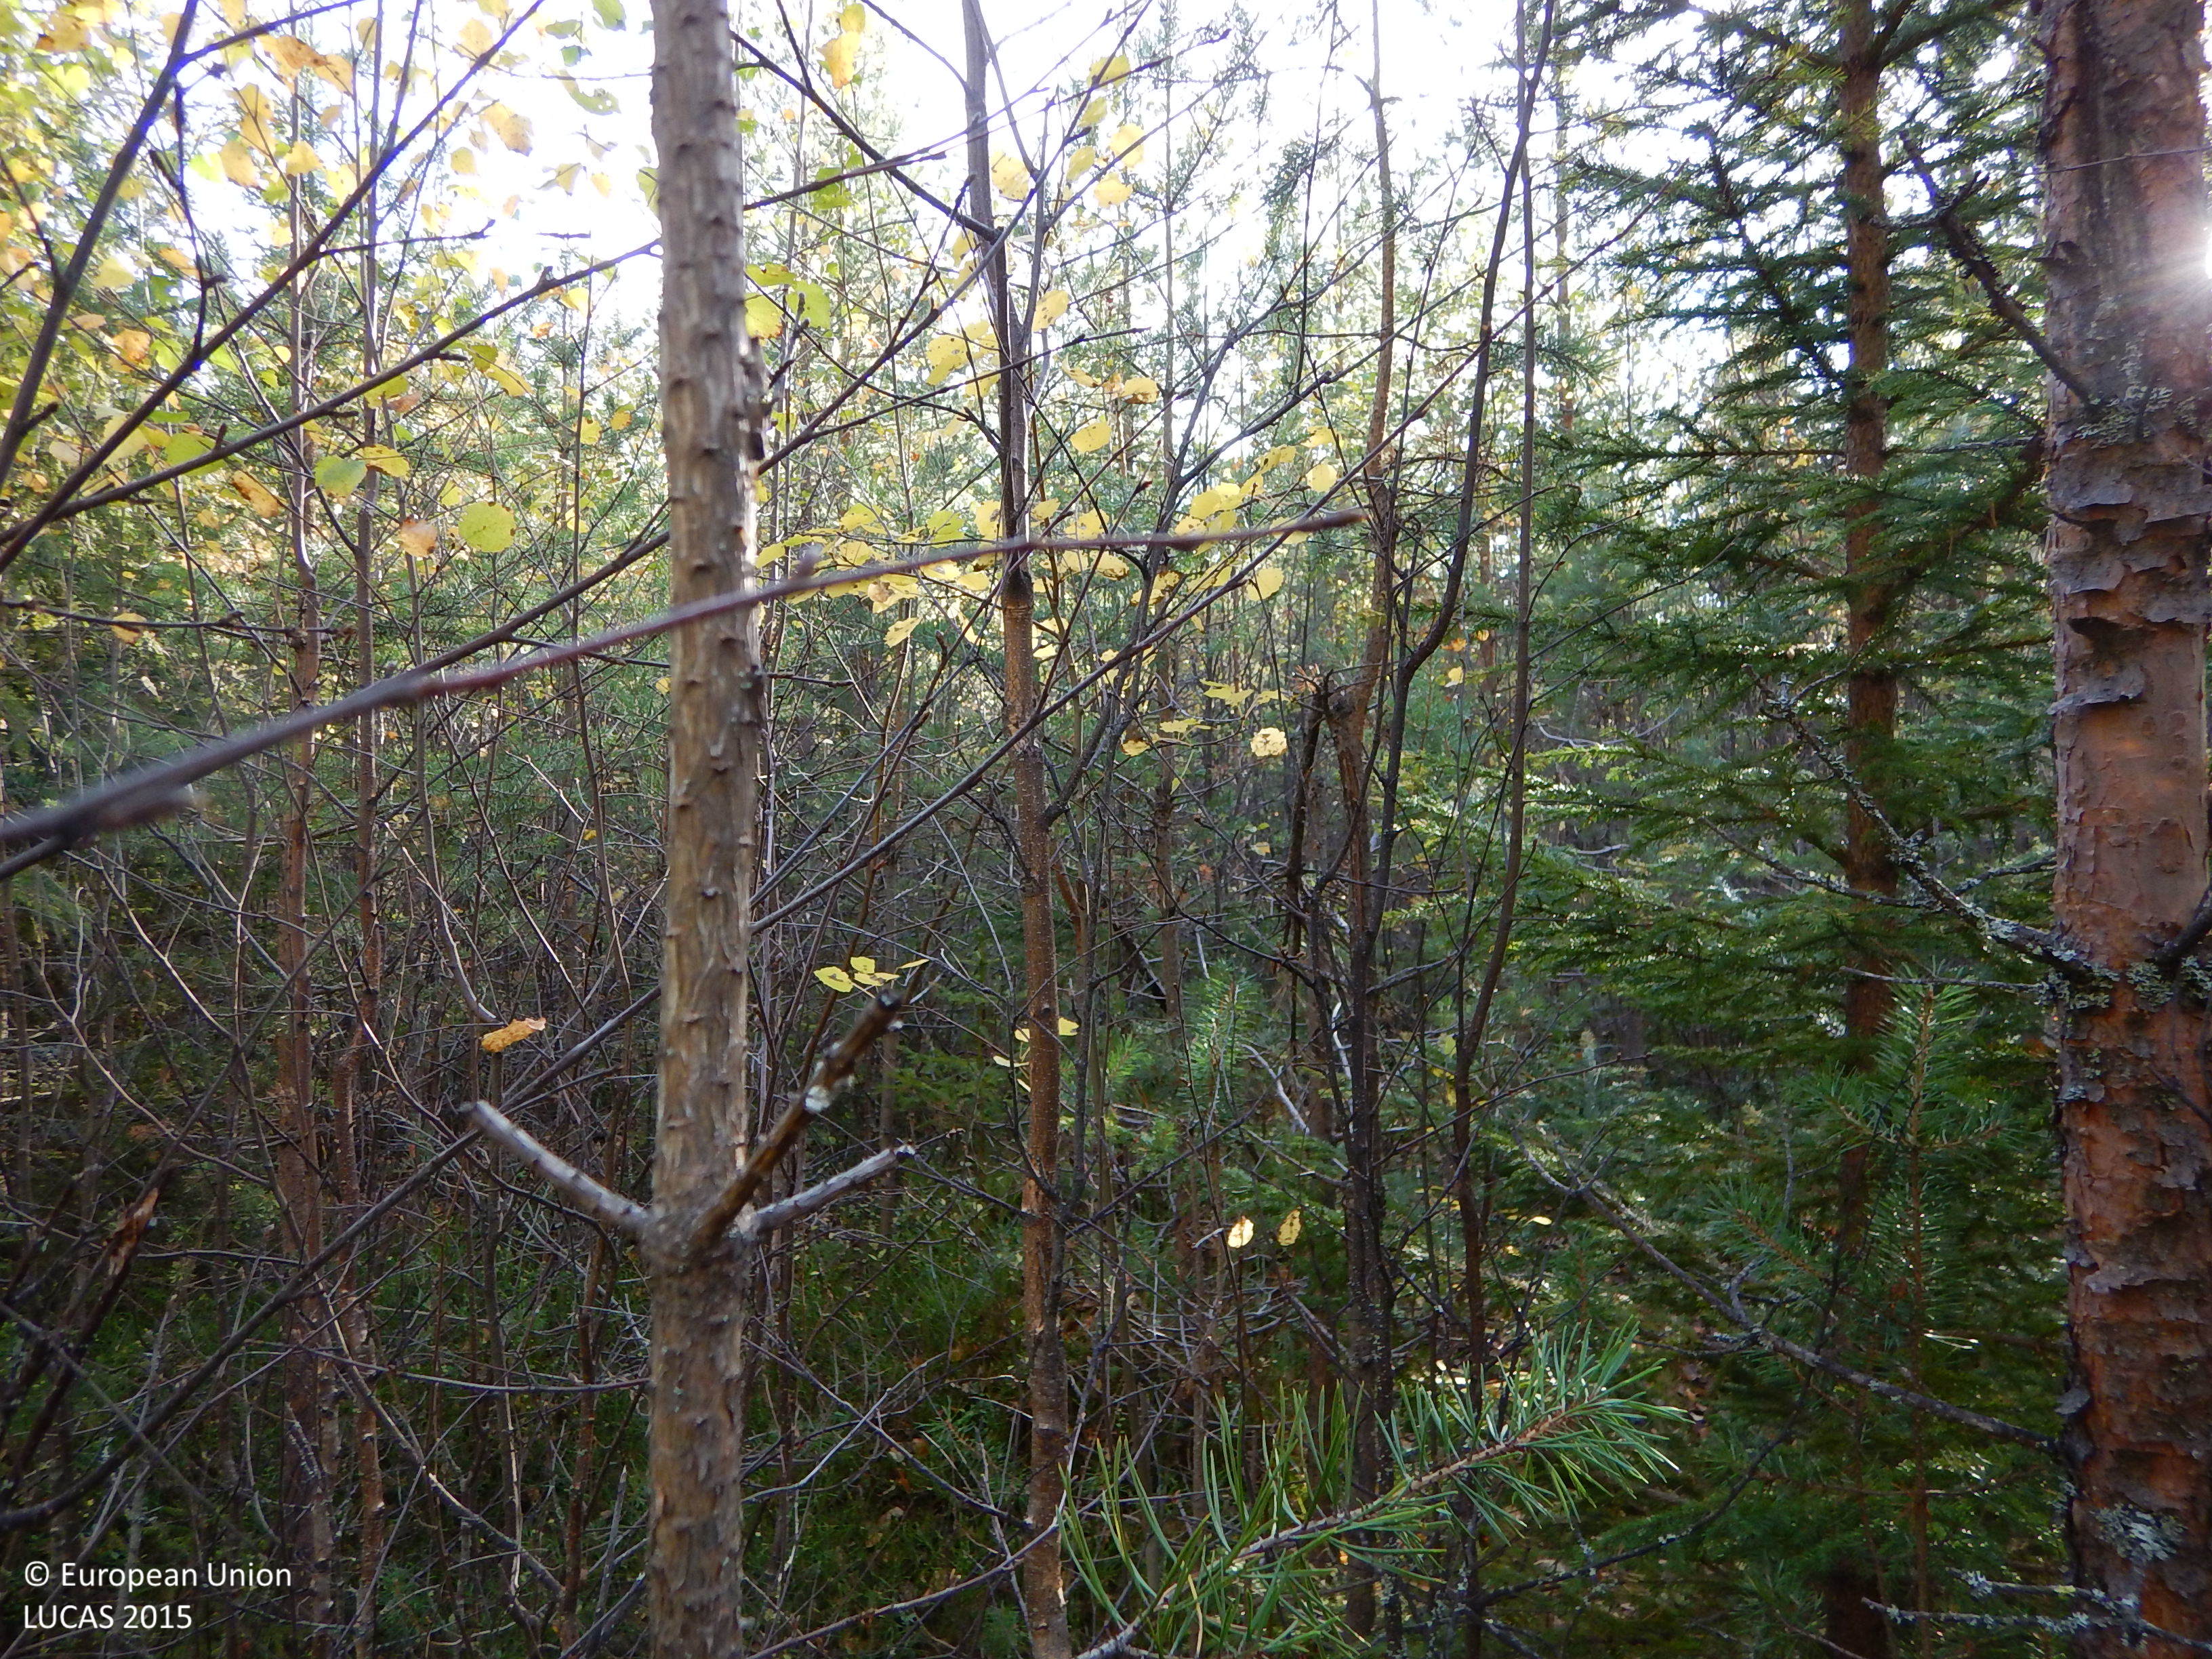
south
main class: Woodland
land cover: Other mixed woodland
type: boreal forest
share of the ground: > 75 %
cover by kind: coniferous forest trees 50 %, broadleaved forest trees 25 %, shrubs 10 %, herbaceous plants 10 %, lichens and mosses 5 %
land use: Forestry
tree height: > 5 m
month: October
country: SE
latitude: 64.9223
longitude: 20.8227
